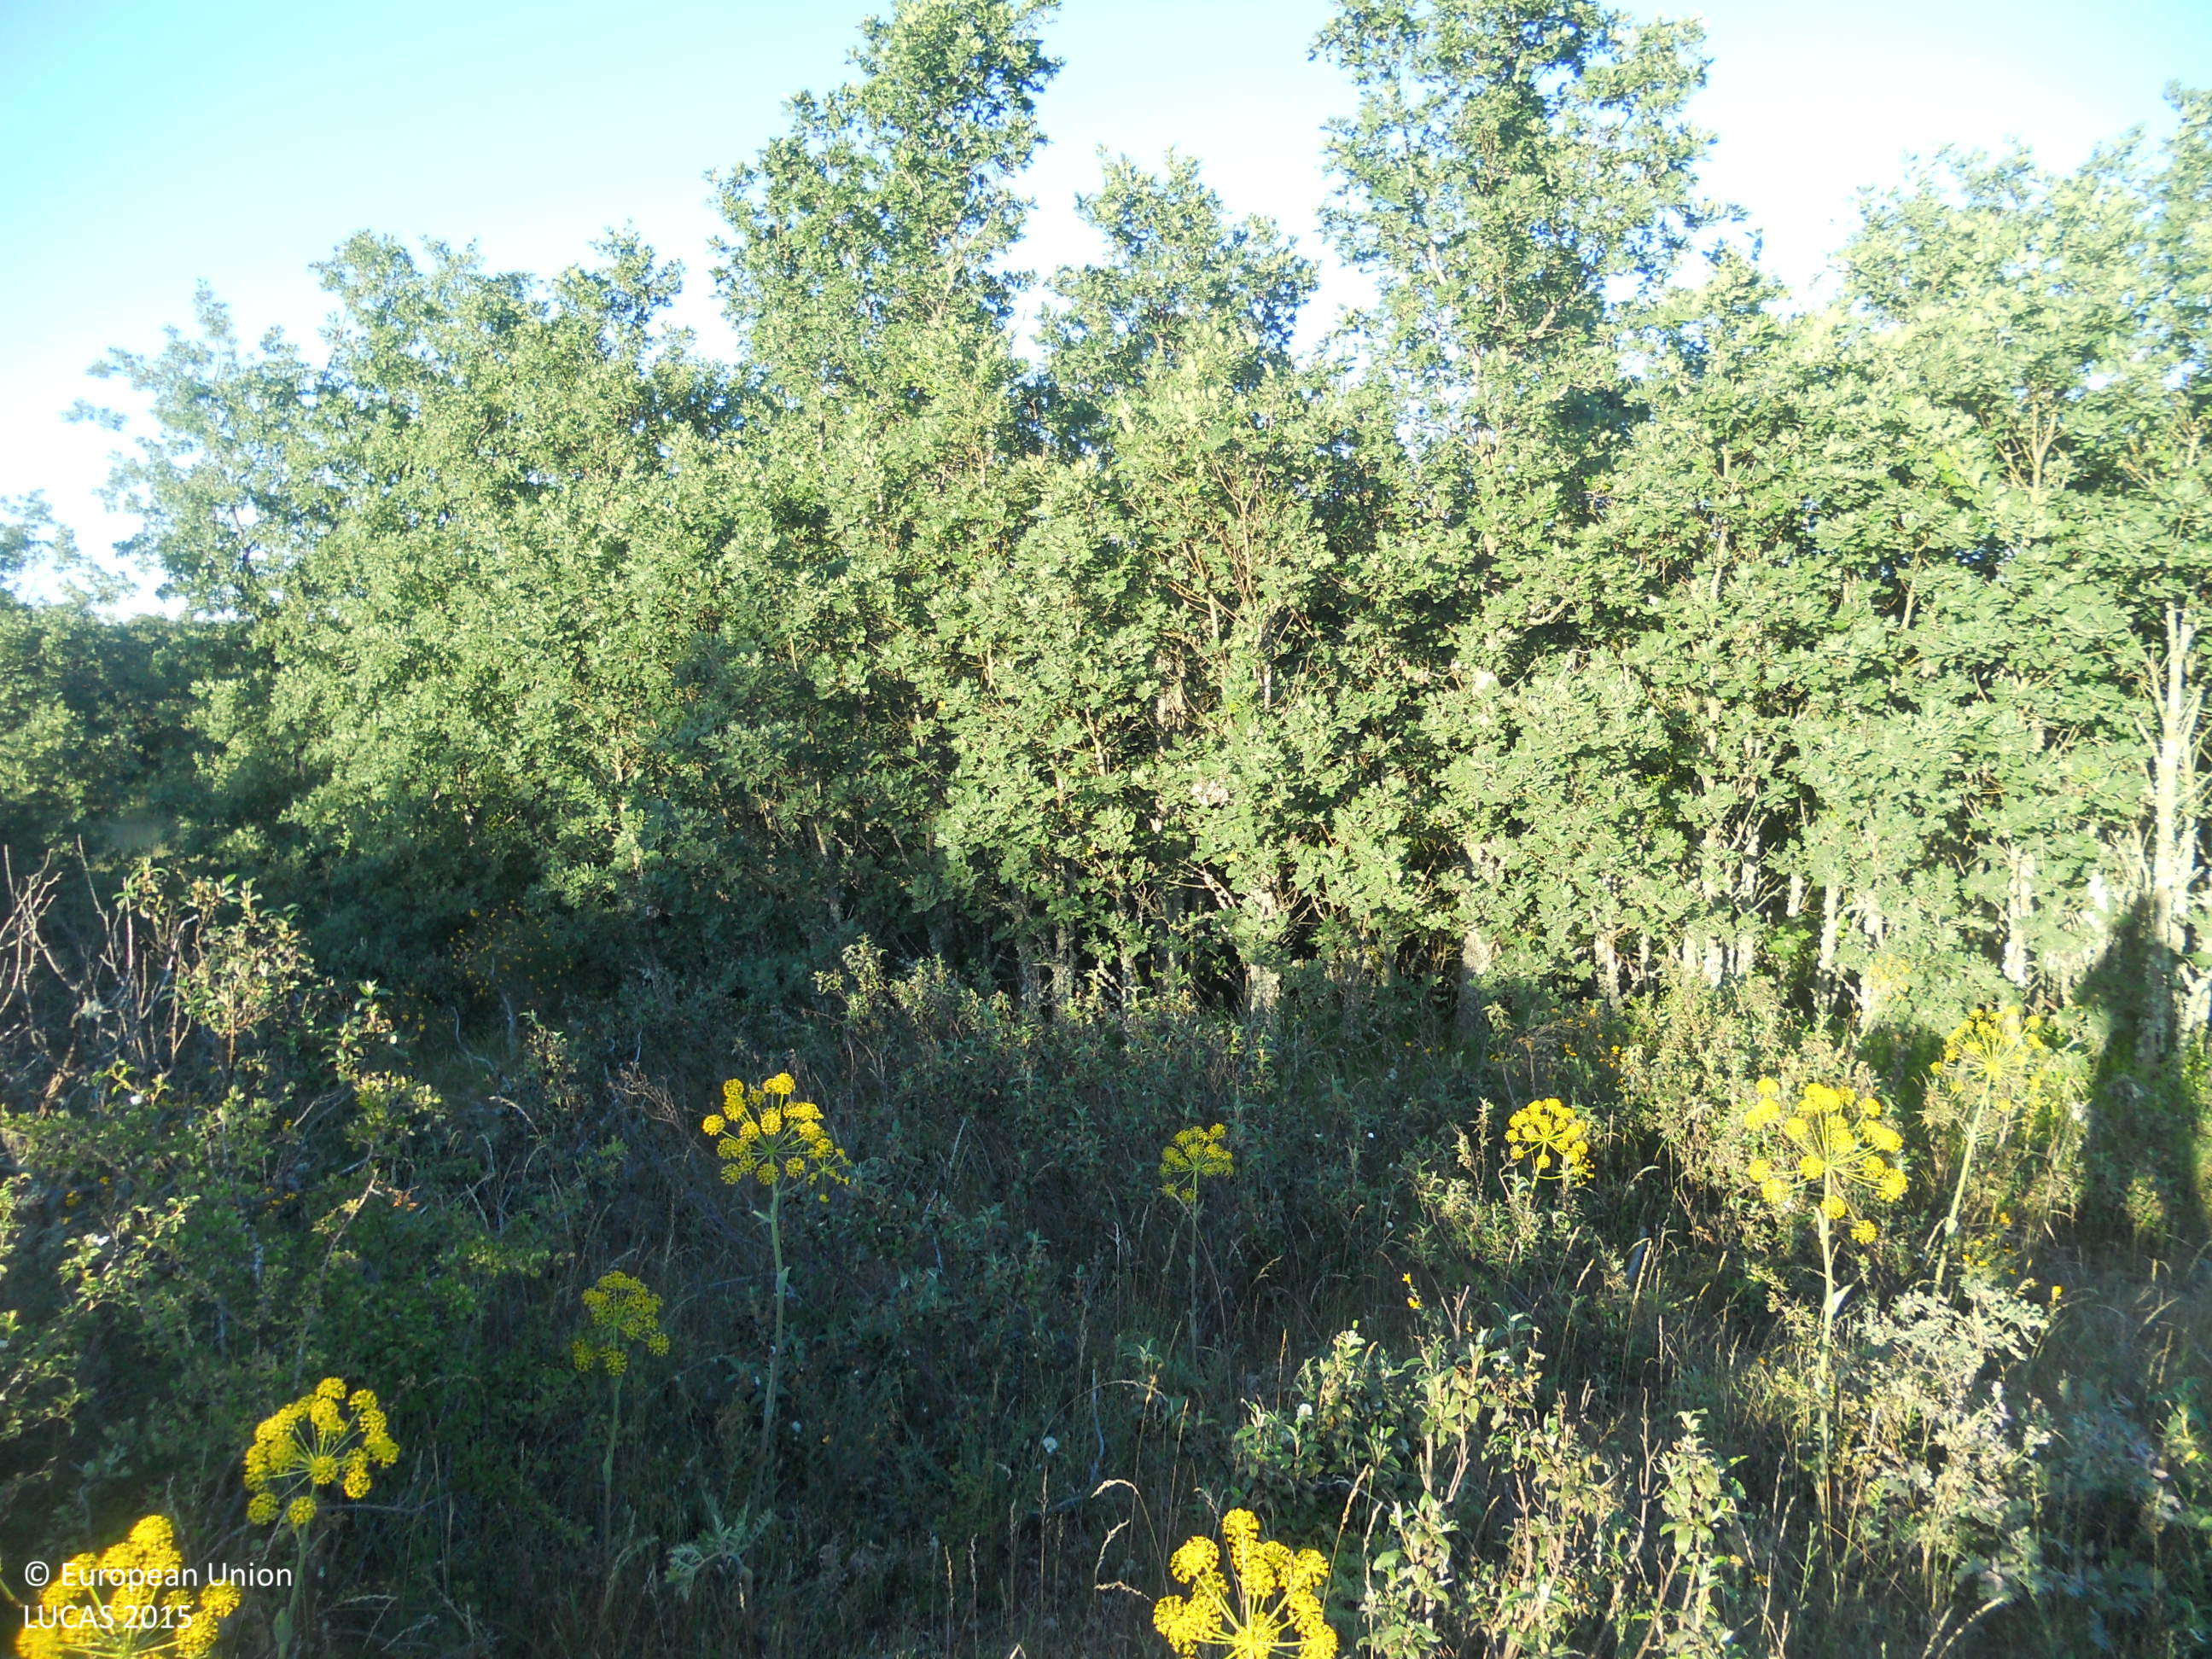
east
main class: Grassland
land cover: Grassland with sparse tree/shrub cover
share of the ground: > 75 %
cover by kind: herbaceous plants 65 %, unconsolidated bare surface 20 %, shrubs 10 %, broadleaved forest trees 5 %
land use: Semi-natural and natural areas not in use
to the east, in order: Grassland with sparse tree/shrub cover; Broadleaved woodland; Grassland without tree/shrub cover; Rivers and streams; Grassland without tree/shrub cover; Broadleaved woodland; Grassland without tree/shrub cover; Rye
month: June
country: ES
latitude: 42.5347
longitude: -4.9004
